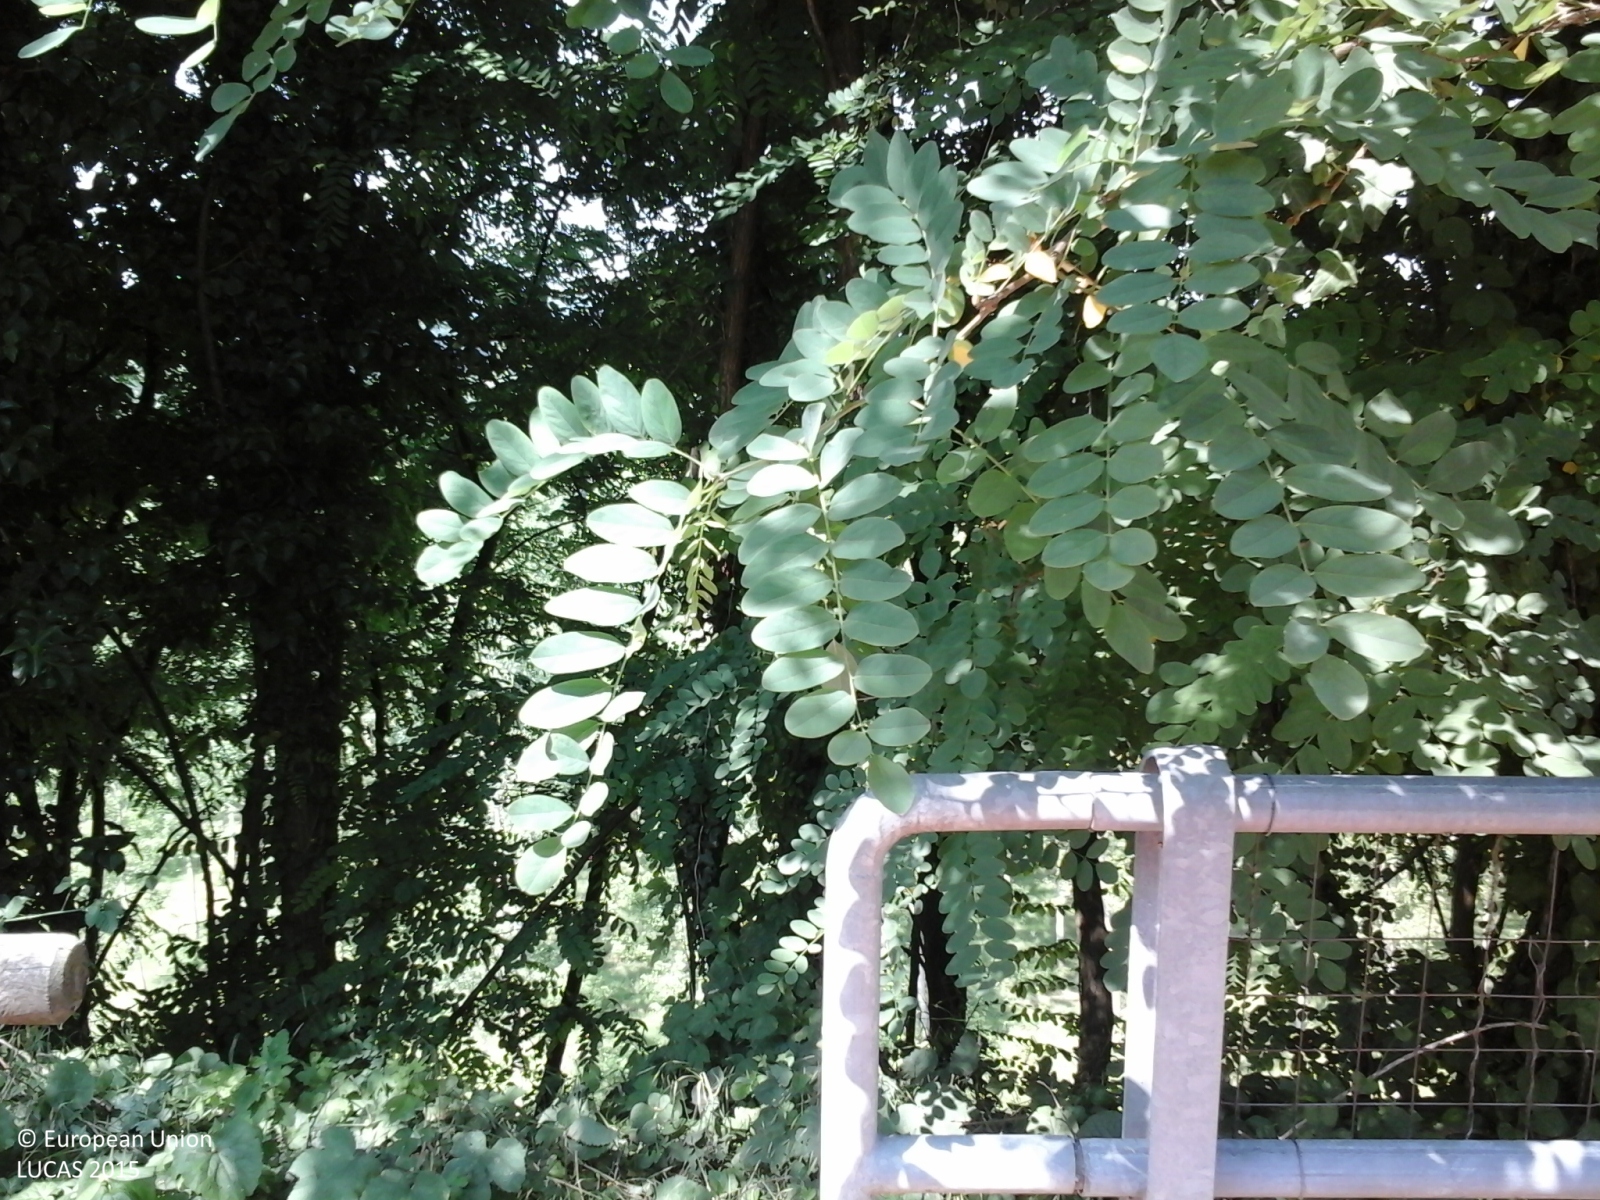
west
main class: Woodland
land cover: Broadleaved woodland
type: thermophilous deciduous forest
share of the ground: > 75 %
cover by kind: broadleaved forest trees 100 %
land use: Forestry
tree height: > 5 m
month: June
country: IT
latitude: 45.5255
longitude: 8.2232
